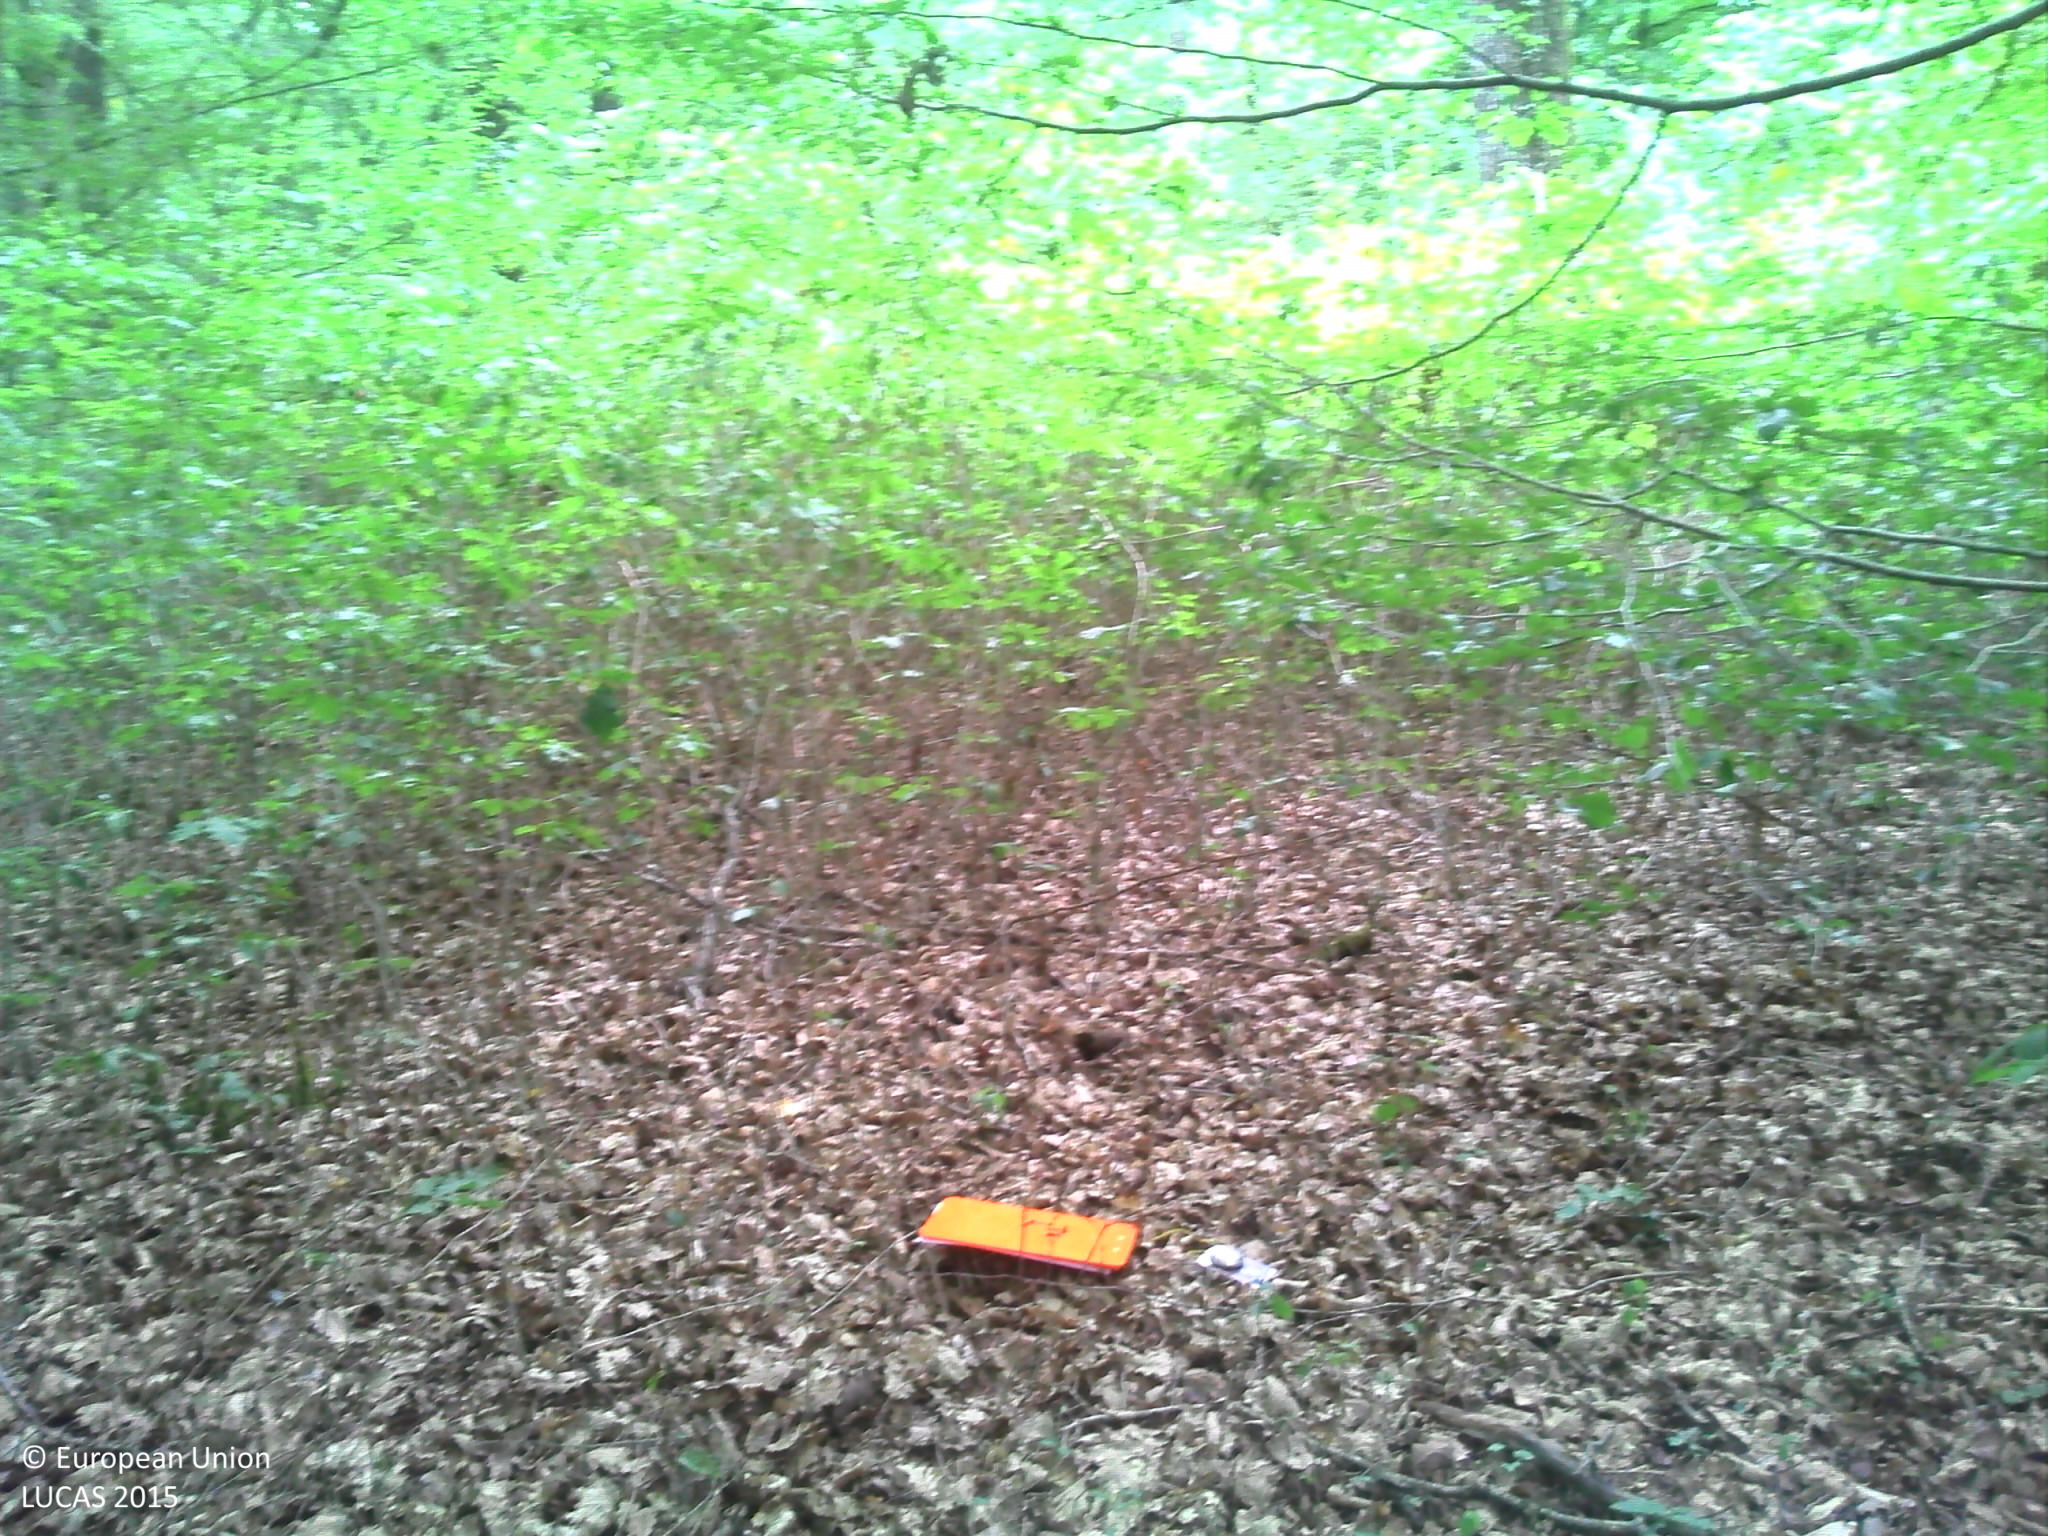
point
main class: Woodland
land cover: Broadleaved woodland
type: mesophytic deciduous forest
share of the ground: > 75 %
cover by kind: broadleaved forest trees 100 %
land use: Forestry
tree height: > 5 m
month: August
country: FR
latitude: 48.0236
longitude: 2.0095
